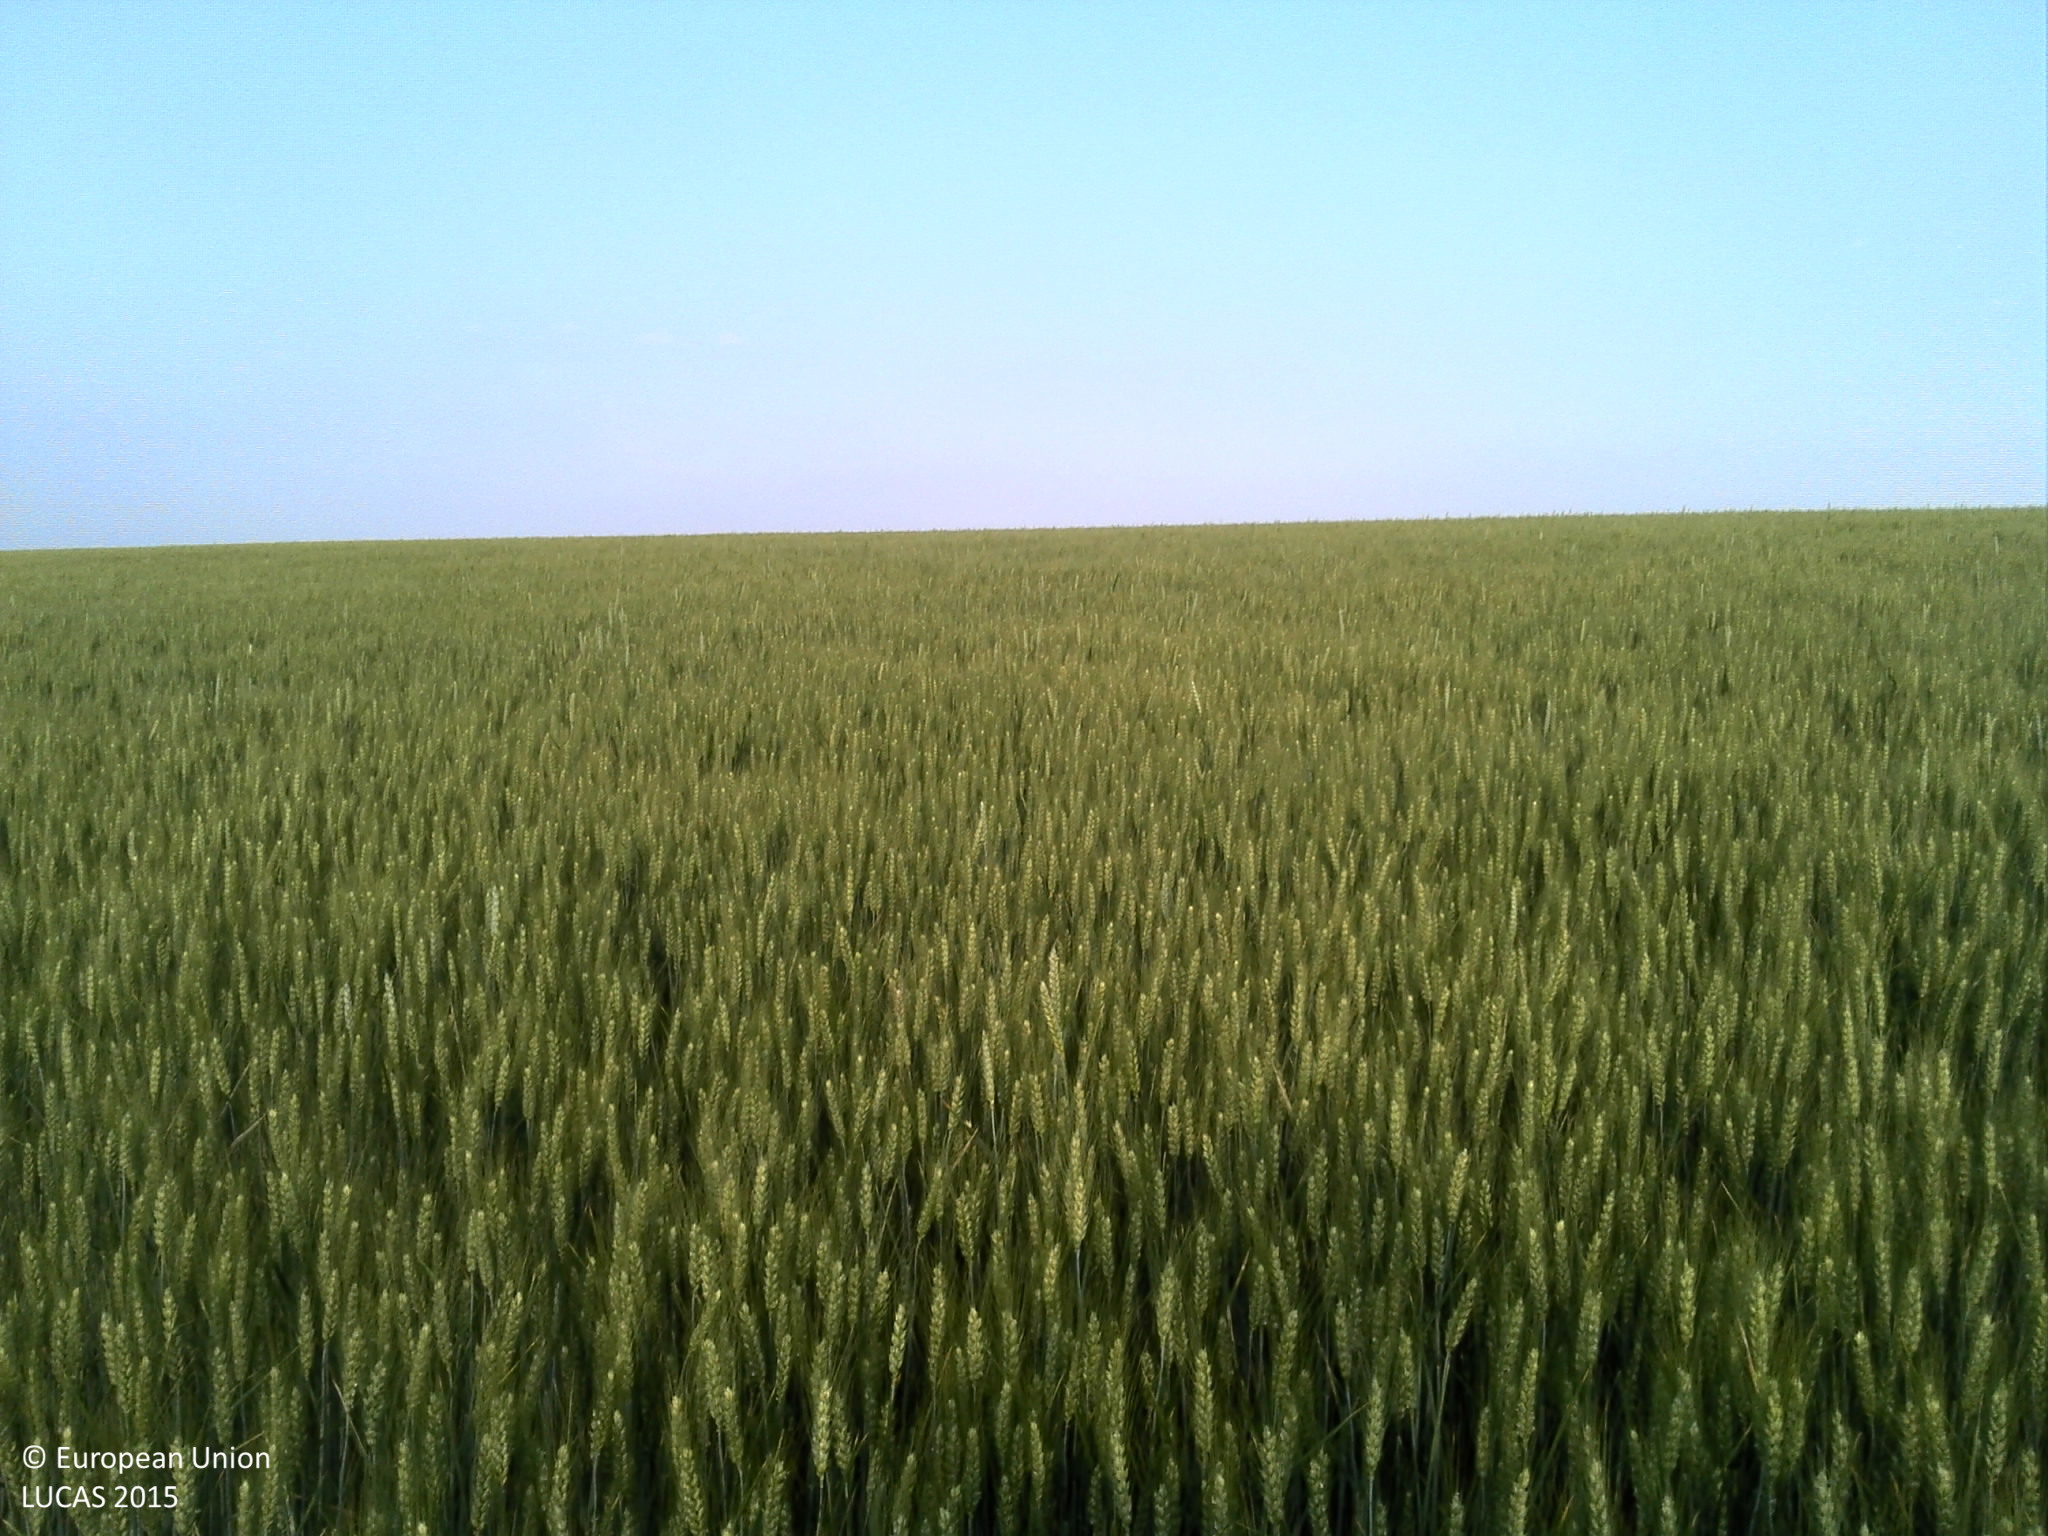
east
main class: Cropland
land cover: Common wheat
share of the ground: > 75 %
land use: Agriculture (excluding fallow land and kitchen gardens)
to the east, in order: Common wheat; Tracks; Grass margins; Barley
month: June
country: FR
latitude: 49.1326
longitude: 6.2582
